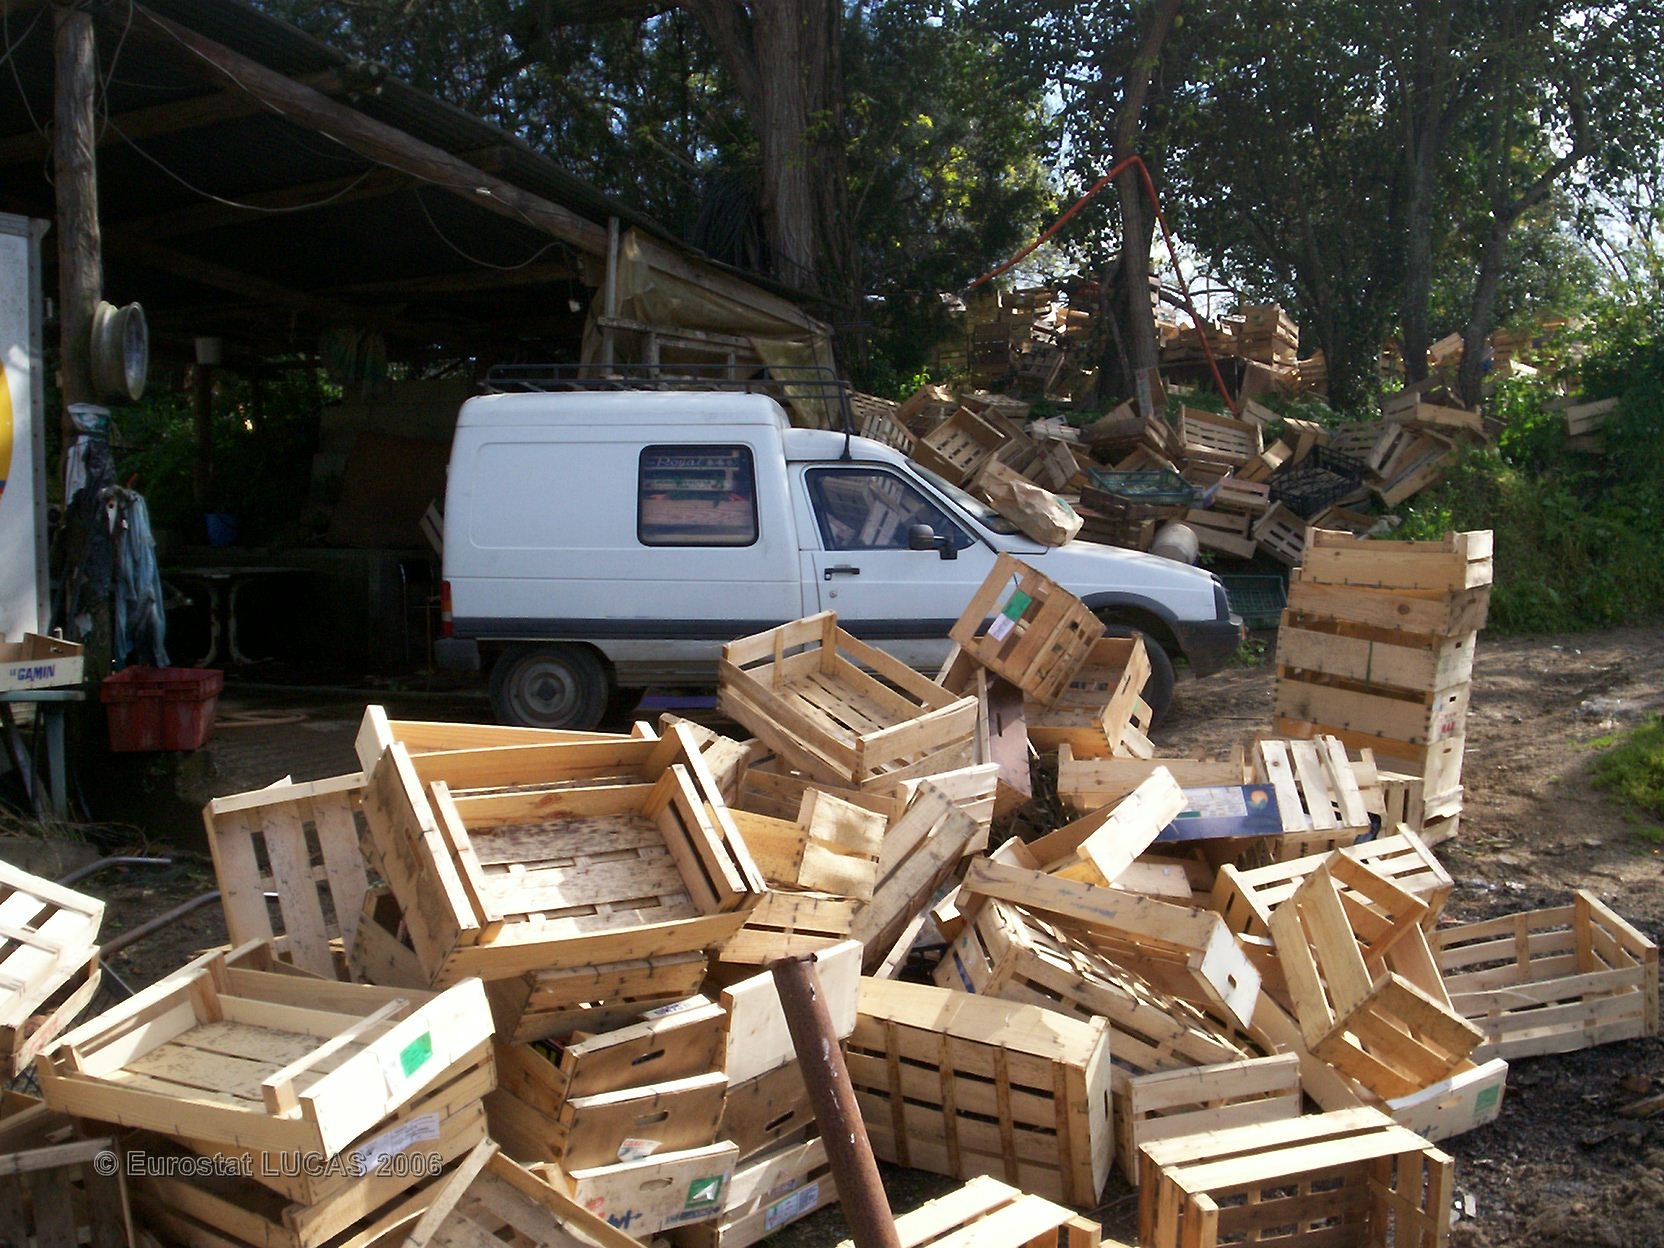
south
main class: Cropland
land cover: Tomatoes
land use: Agriculture (excluding fallow land and kitchen gardens)
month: April
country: FR
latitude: 41.9415
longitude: 8.7384
